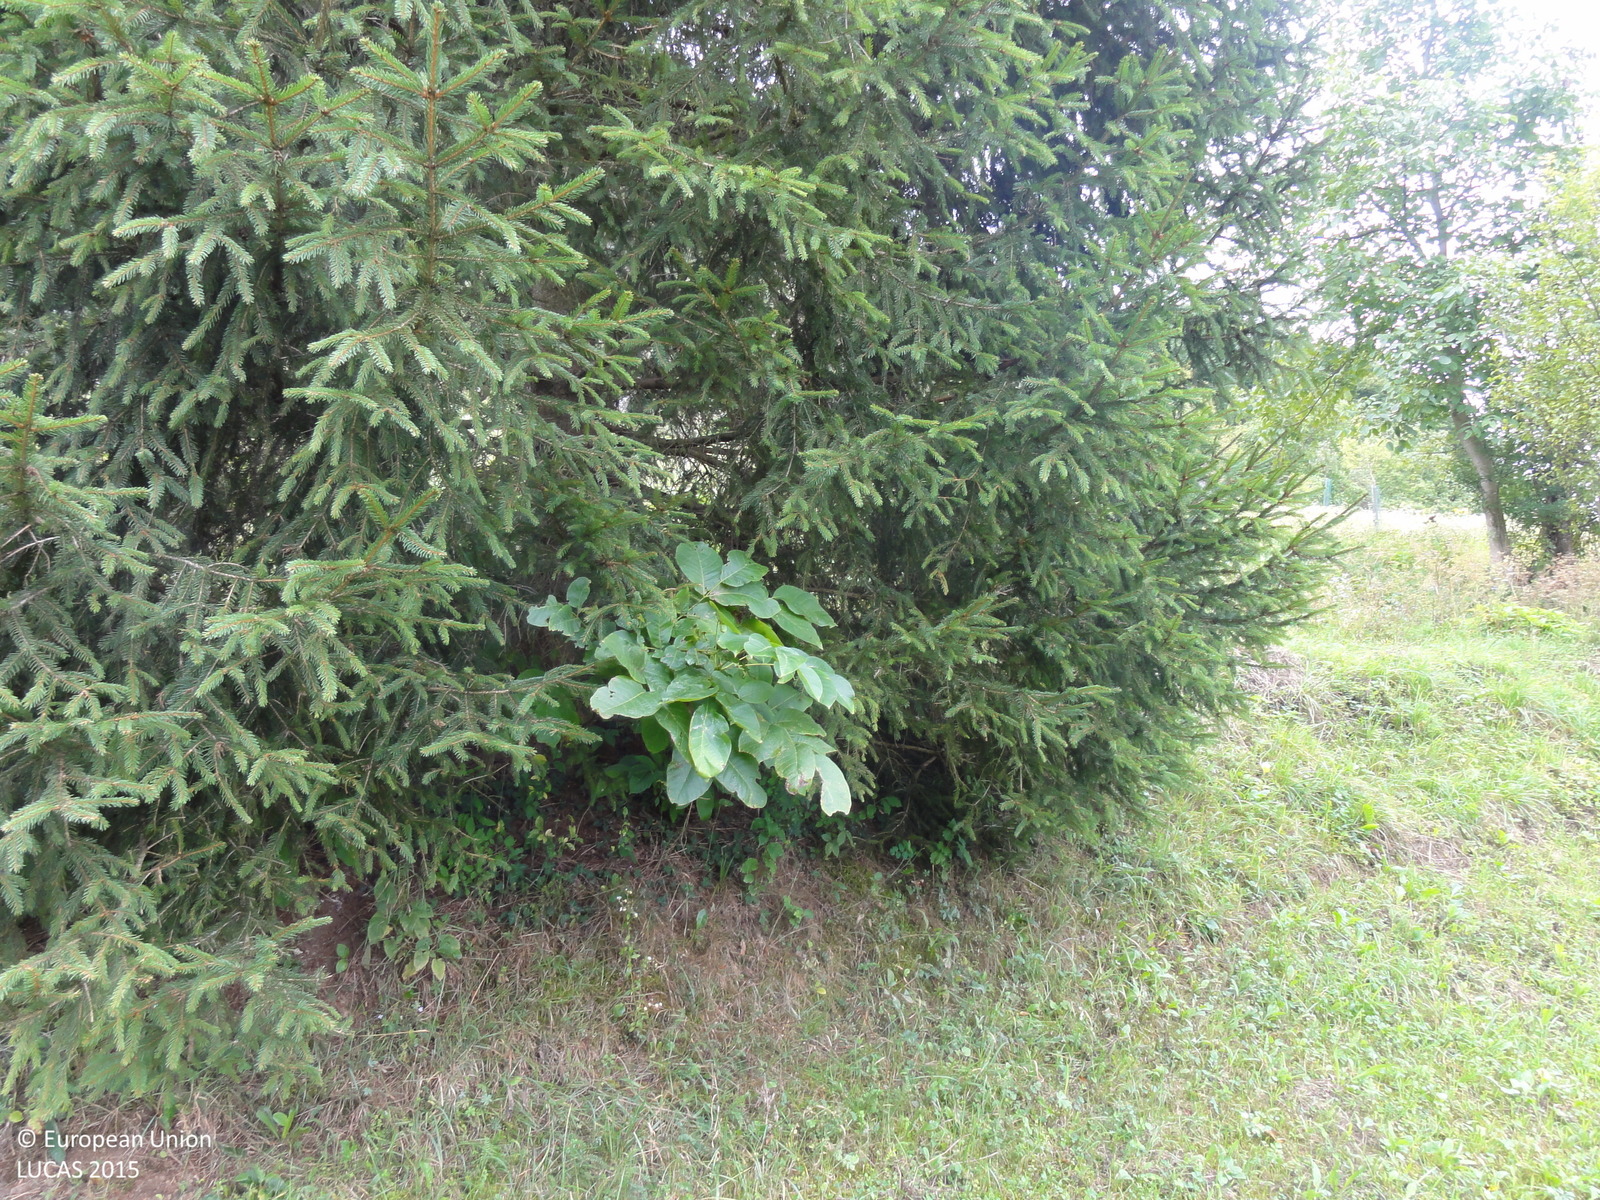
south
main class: Grassland
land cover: Grassland with sparse tree/shrub cover
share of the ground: > 75 %
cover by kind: herbaceous plants 90 %, coniferous forest trees 5 %, shrubs 5 %
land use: Agriculture (excluding fallow land and kitchen gardens)
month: August
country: SI
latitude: 46.0563
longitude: 15.6722
